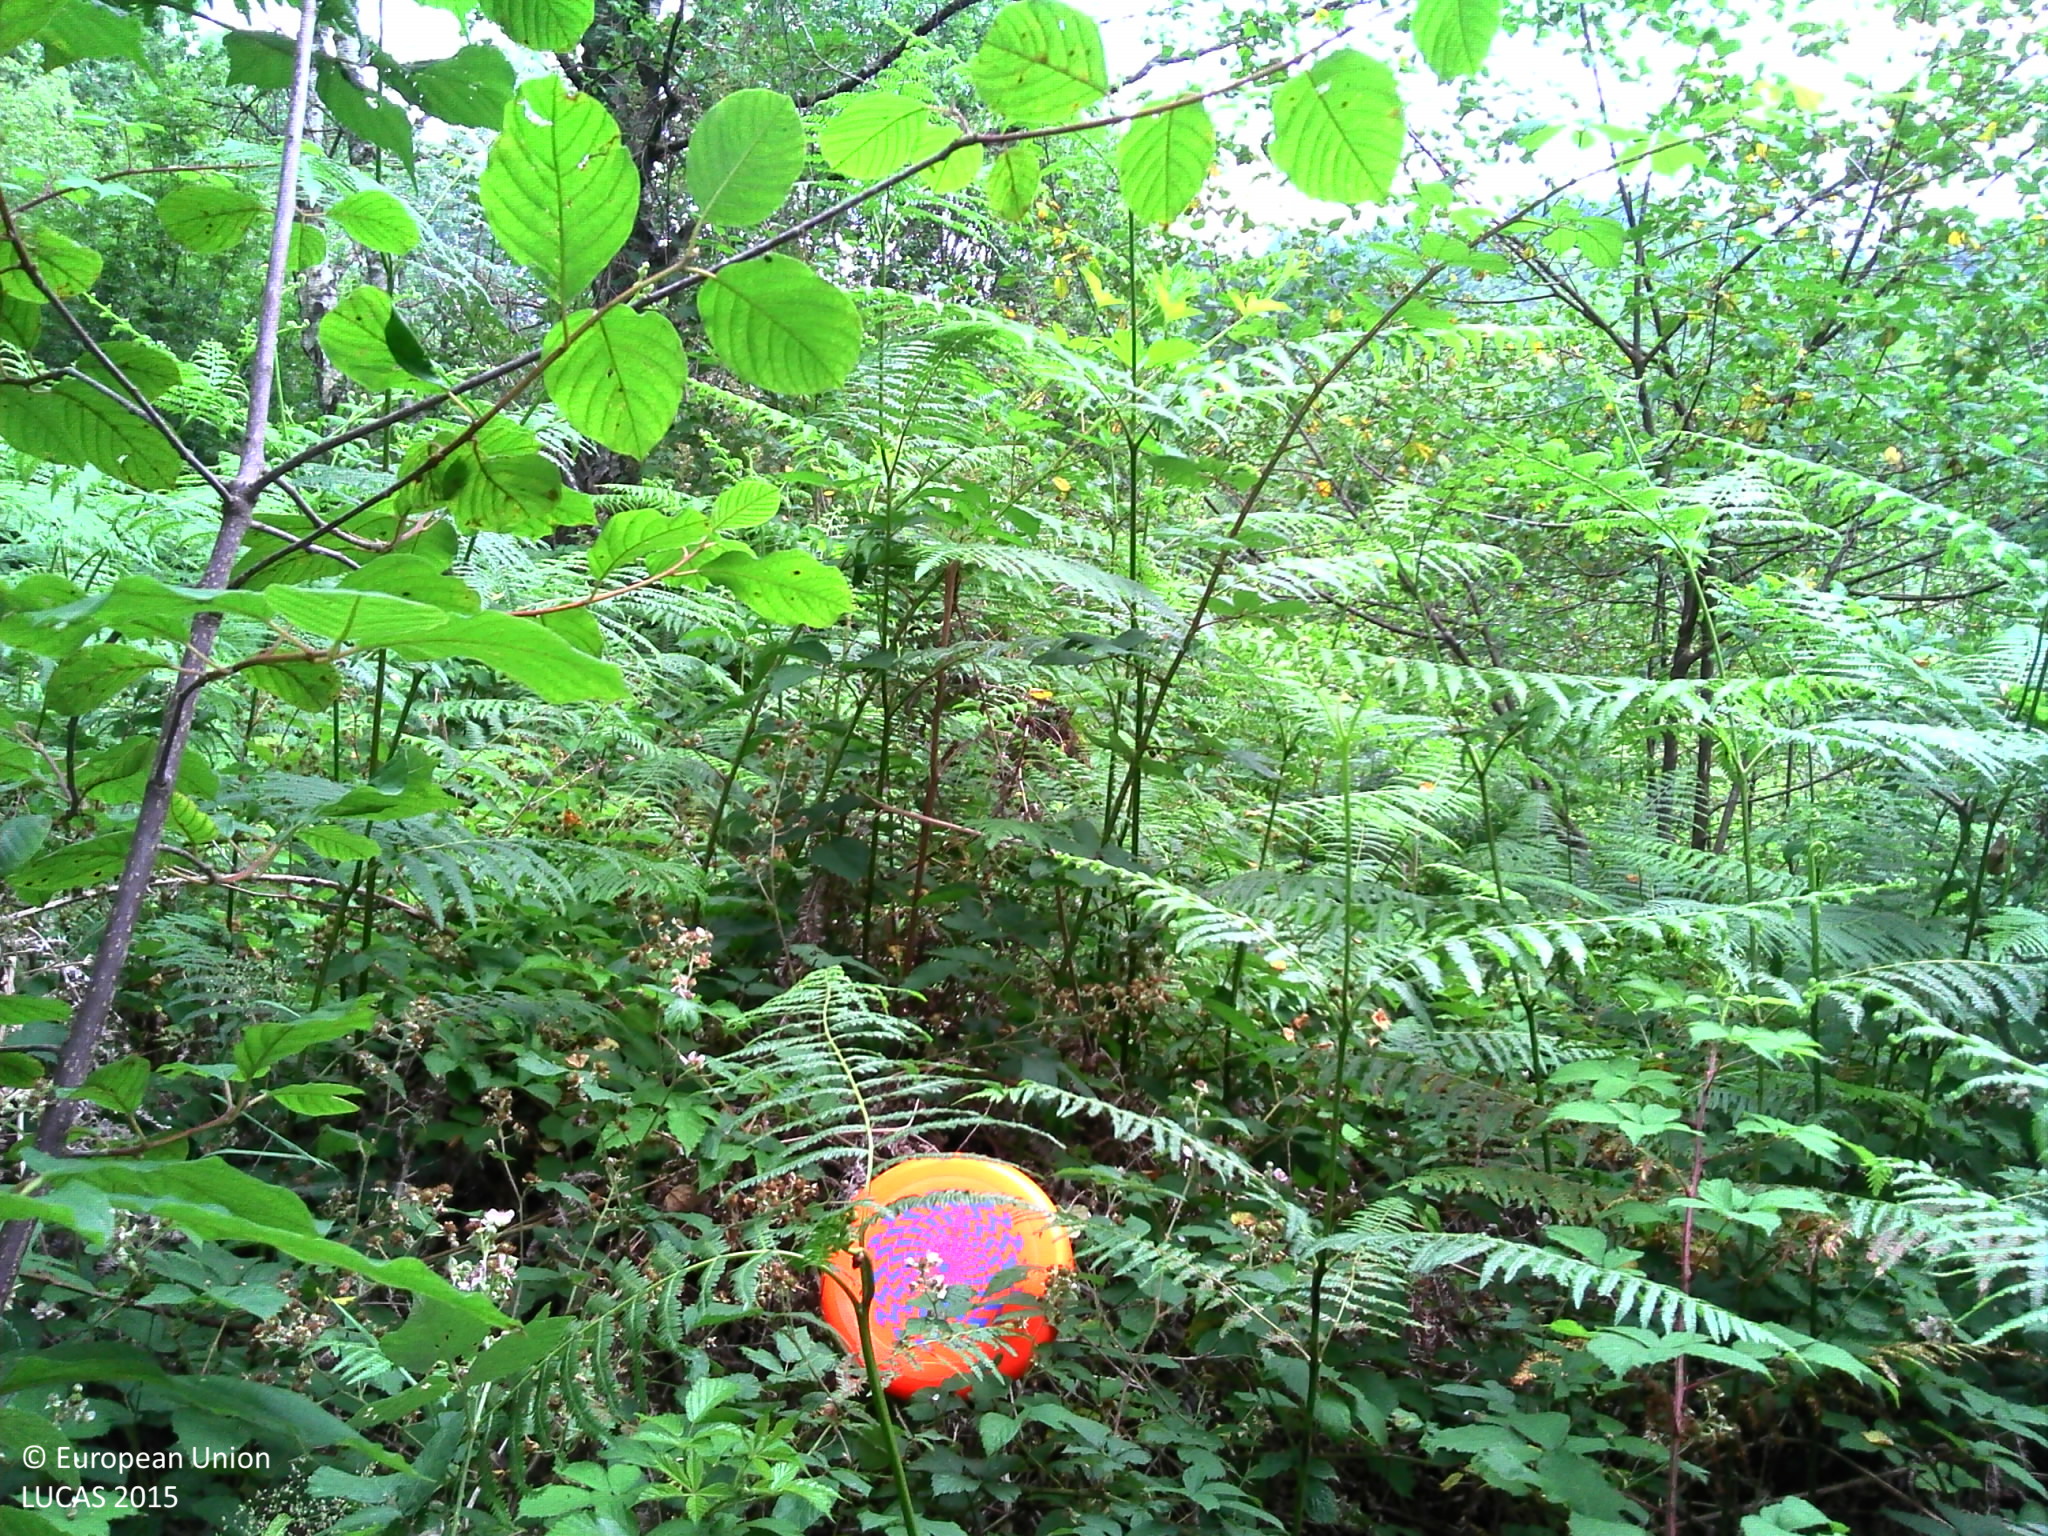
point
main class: Woodland
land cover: Broadleaved woodland
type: non-riverine alder, birch or aspen forest
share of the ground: > 75 %
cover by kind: broadleaved forest trees 40 %, herbaceous plants 40 %, lichens and mosses 20 %
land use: Forestry
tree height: < 5 m
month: July
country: FR
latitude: 45.7846
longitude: 1.8265
